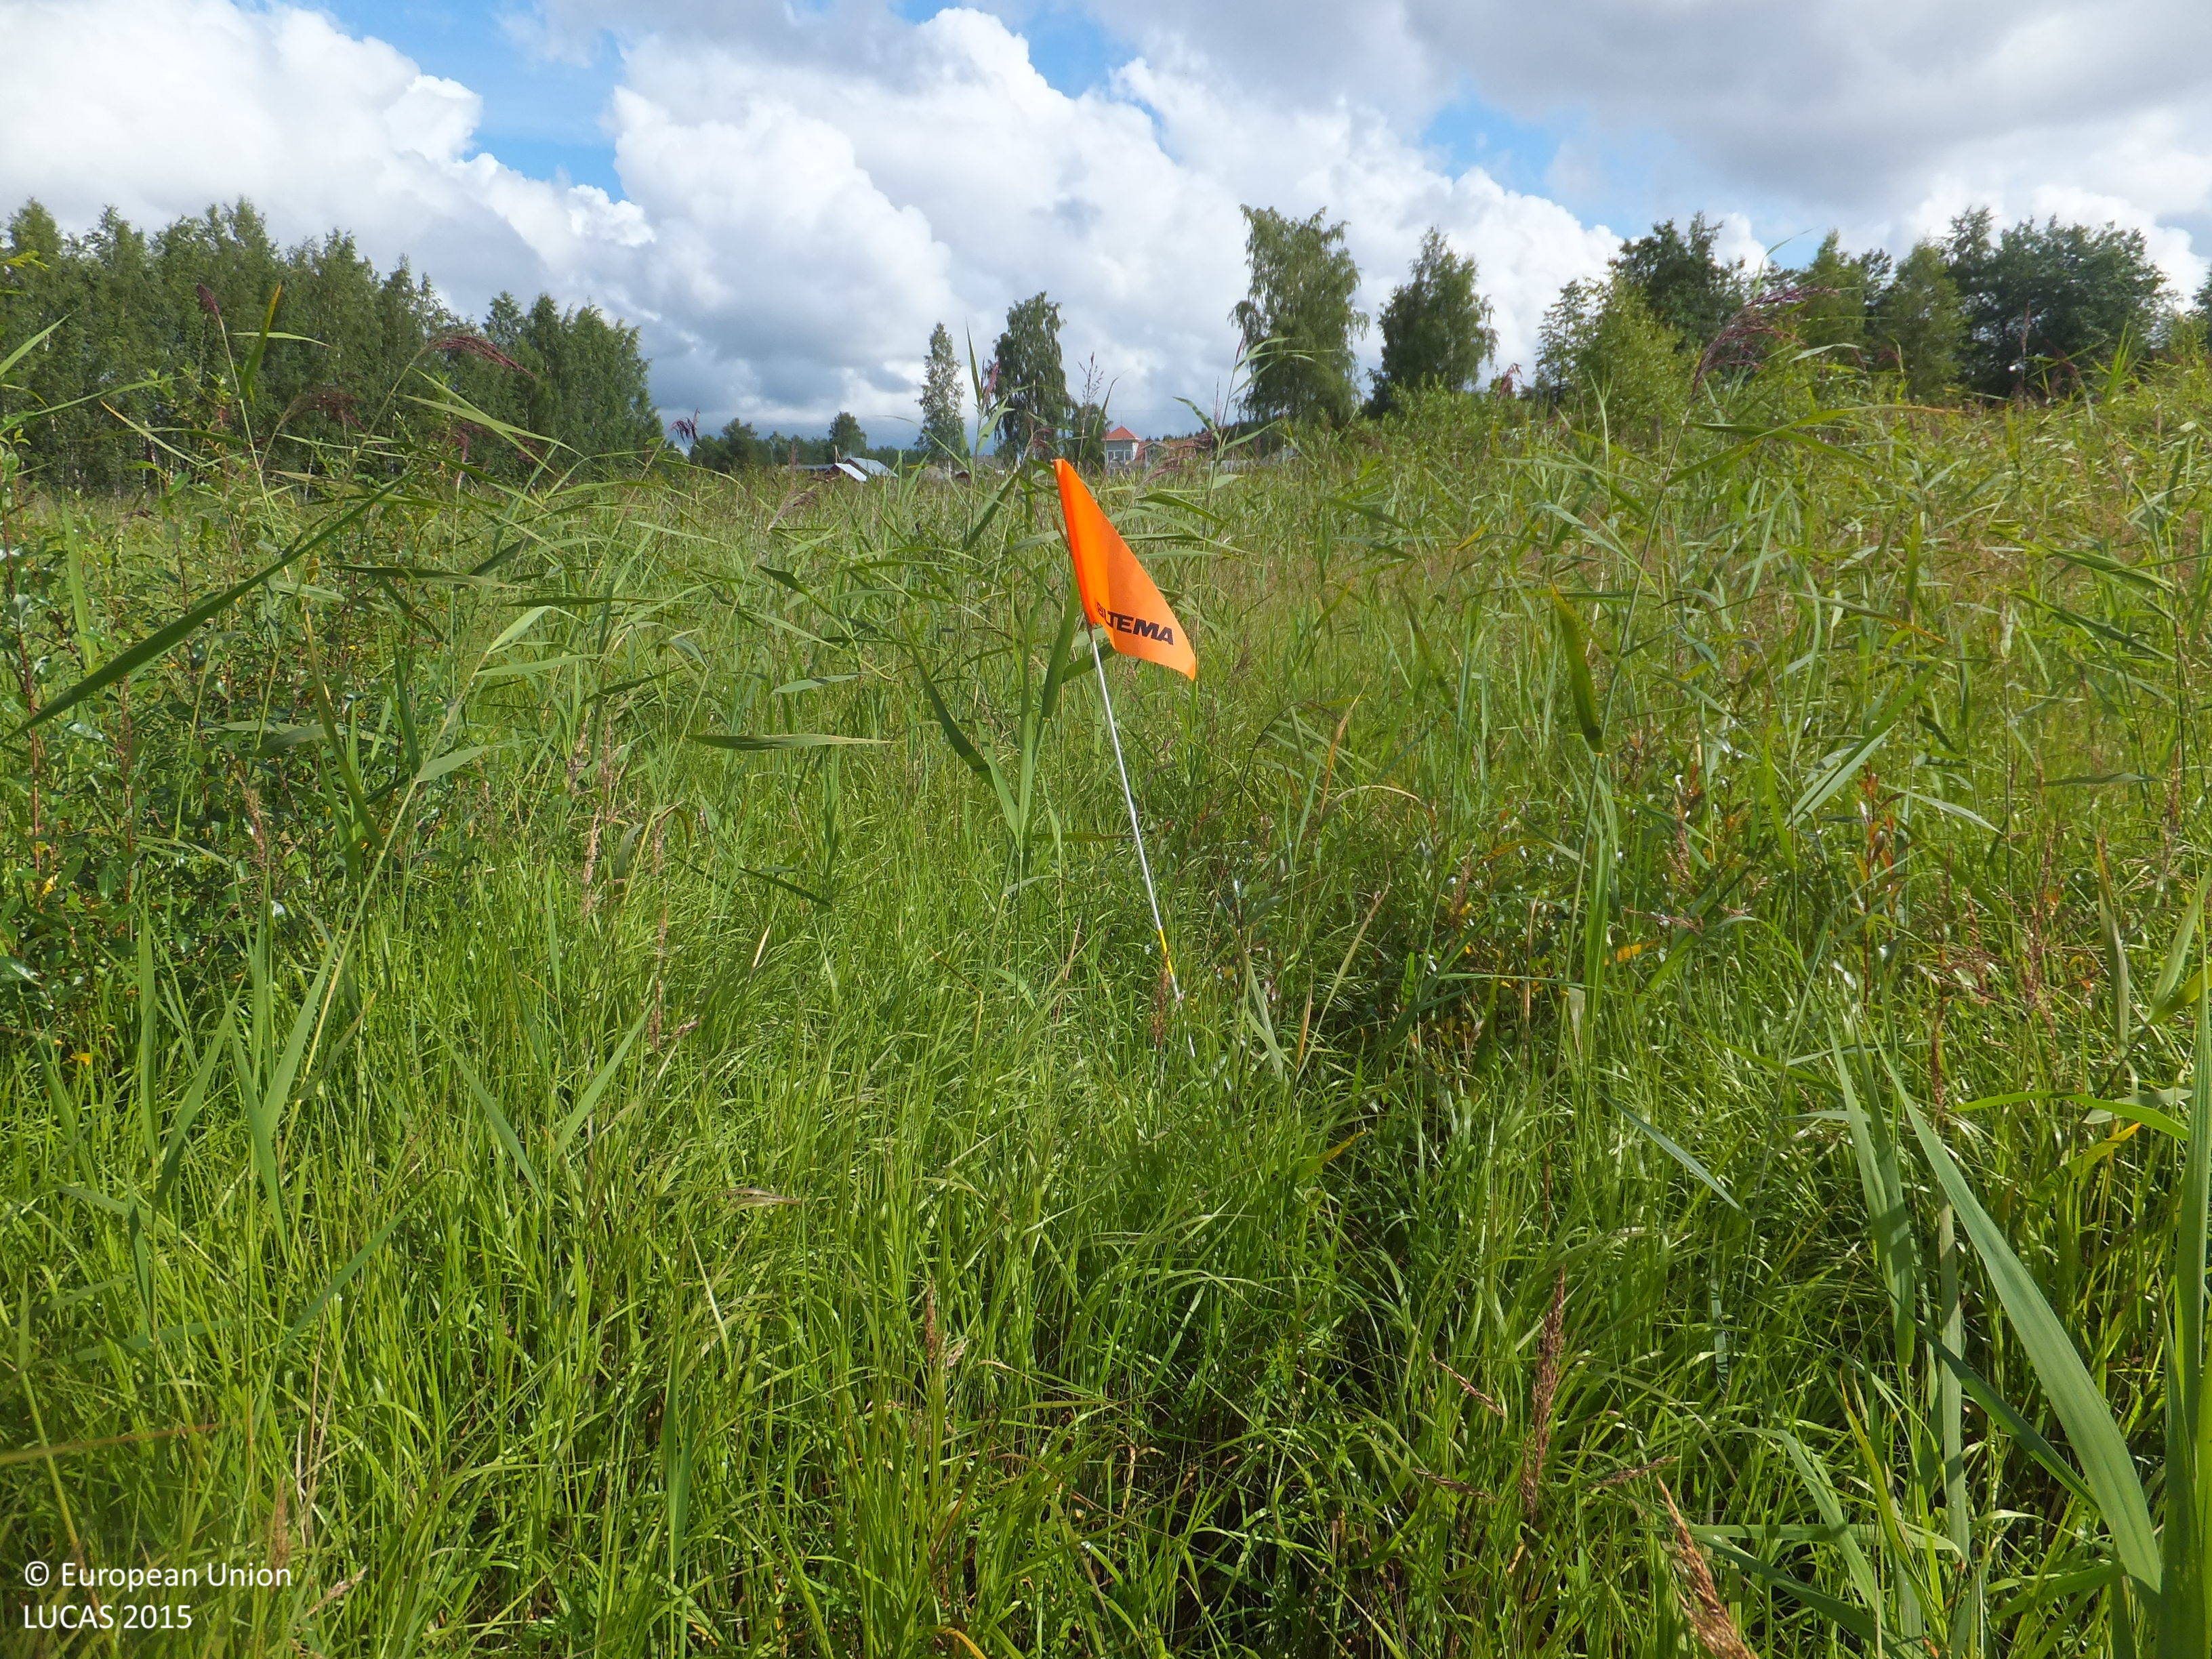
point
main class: Grassland
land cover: Grassland without tree/shrub cover
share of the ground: > 75 %
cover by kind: herbaceous plants 100 %
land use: Semi-natural and natural areas not in use
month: July
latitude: 63.2243
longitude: 22.0414
